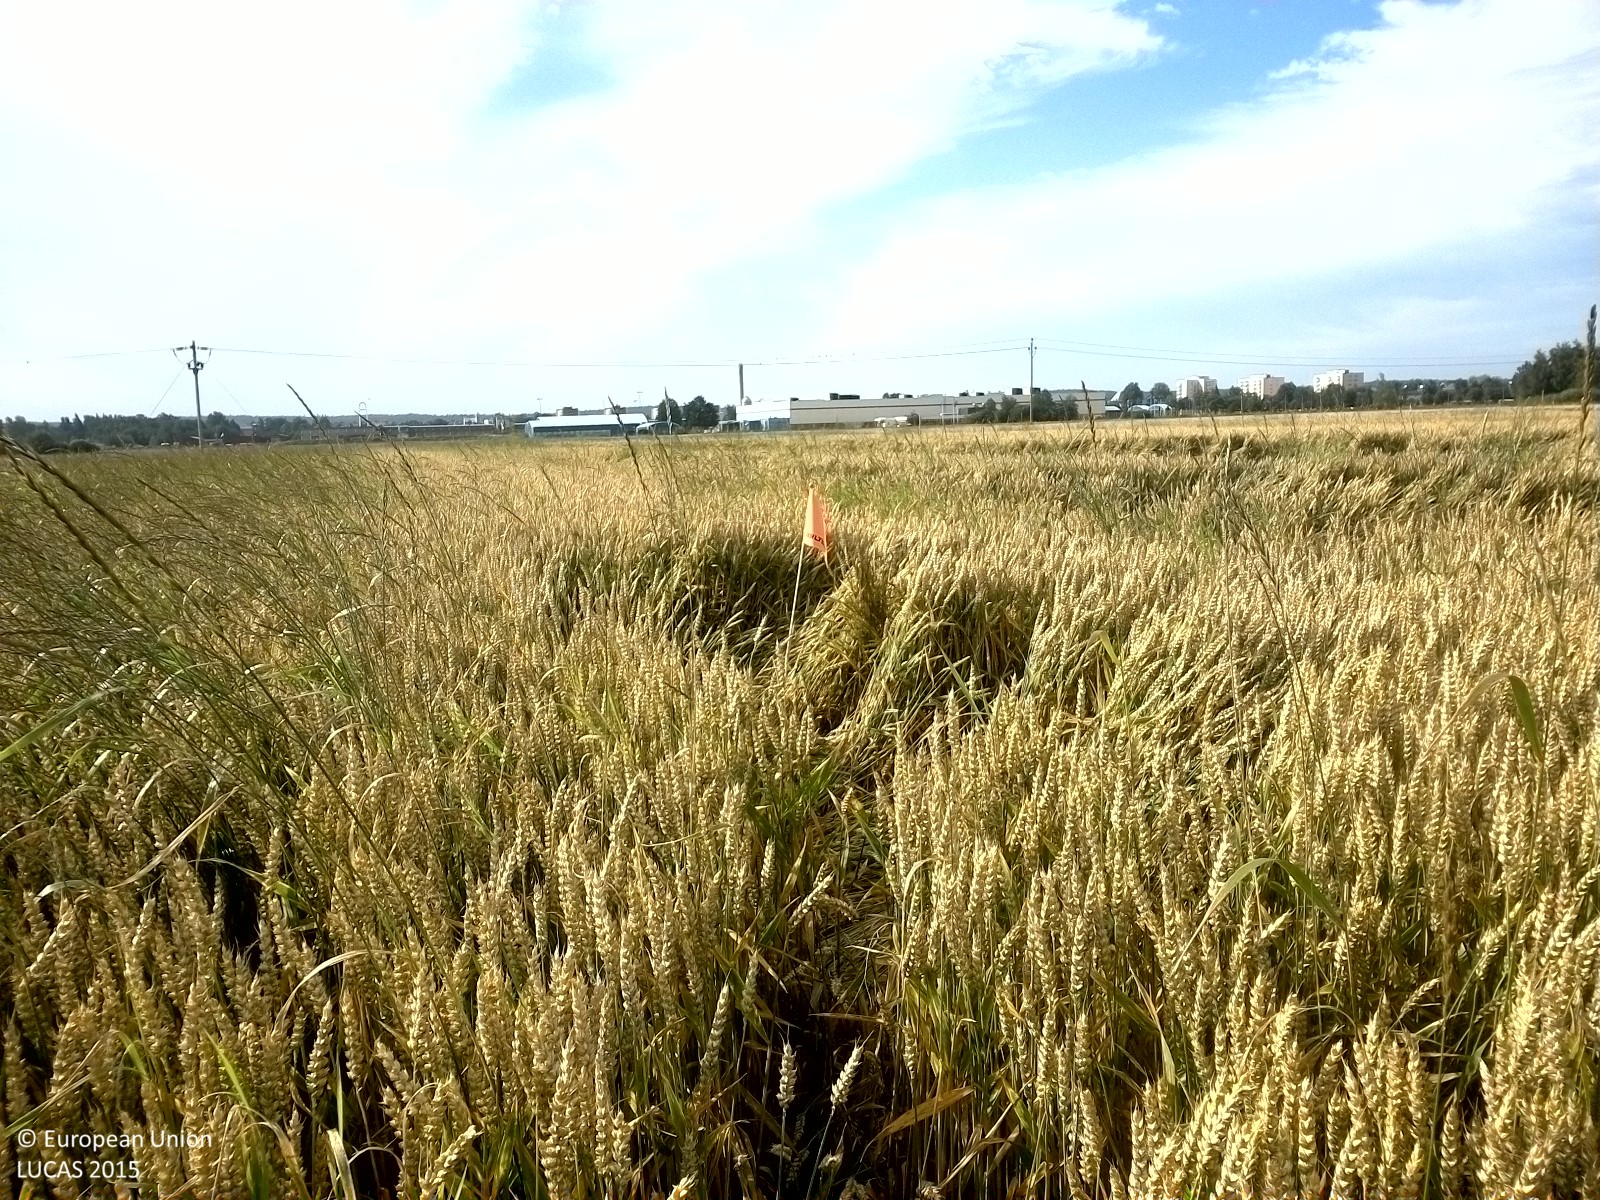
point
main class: Cropland
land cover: Common wheat
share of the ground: > 75 %
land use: Agriculture (excluding fallow land and kitchen gardens)
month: August
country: SE
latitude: 59.0782
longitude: 15.1041
